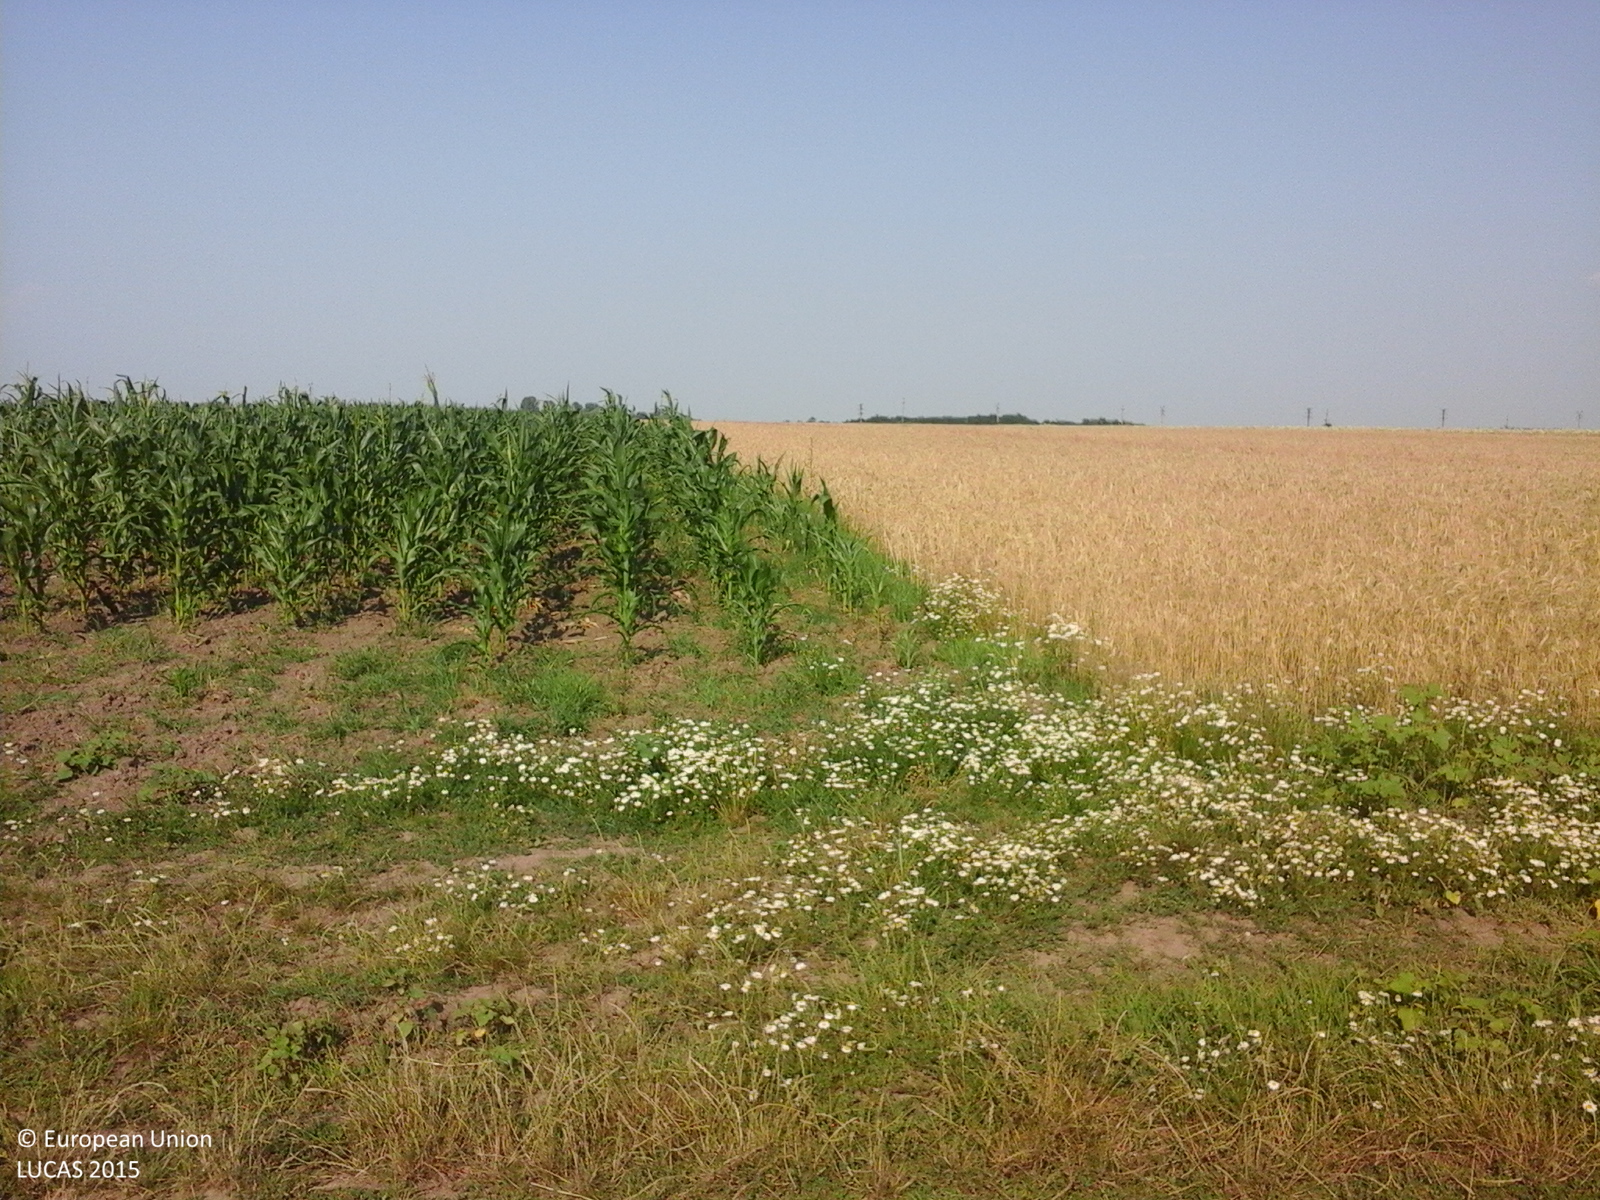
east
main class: Cropland
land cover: Common wheat
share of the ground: > 75 %
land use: Agriculture (excluding fallow land and kitchen gardens)
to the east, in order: Common wheat; Tracks; Grass margins; Common wheat
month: July
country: RO
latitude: 44.6245
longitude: 24.5036
